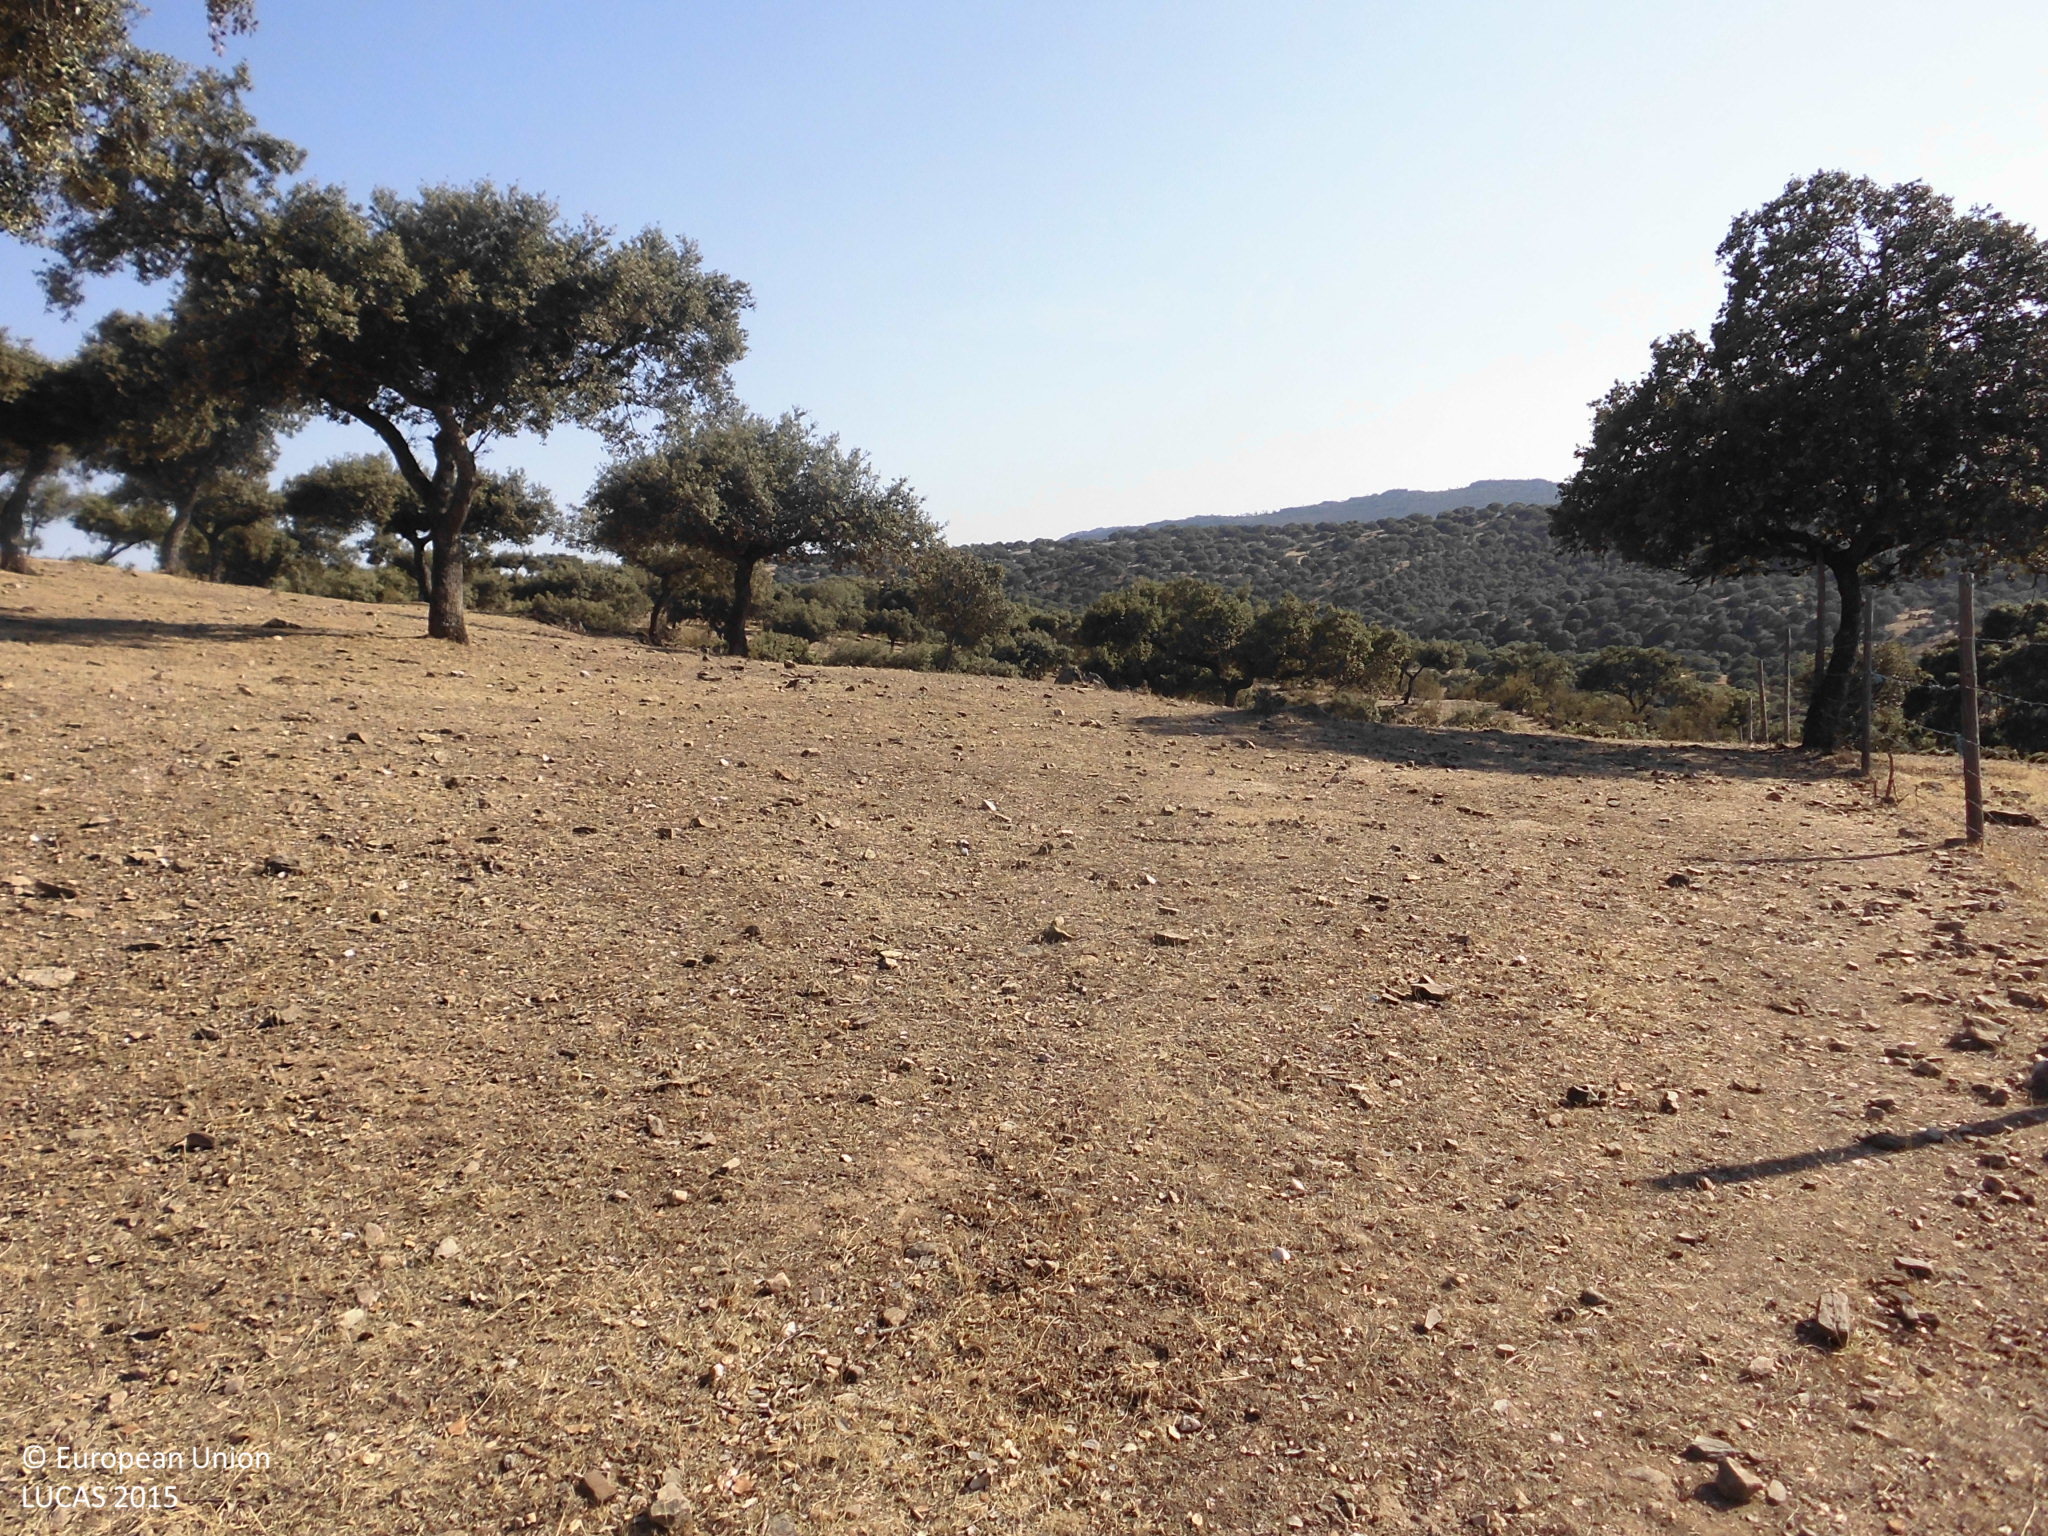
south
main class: Woodland
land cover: Broadleaved woodland
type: broadleaved evergreen forest
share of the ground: 10 - 25 %
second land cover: Grassland without tree/shrub cover
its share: > 75 %
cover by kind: herbaceous plants 80 %, broadleaved forest trees 20 %
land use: Forestry
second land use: Agriculture (excluding fallow land and kitchen gardens)
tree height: > 5 m
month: July
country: ES
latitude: 39.9461
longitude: -6.7147
